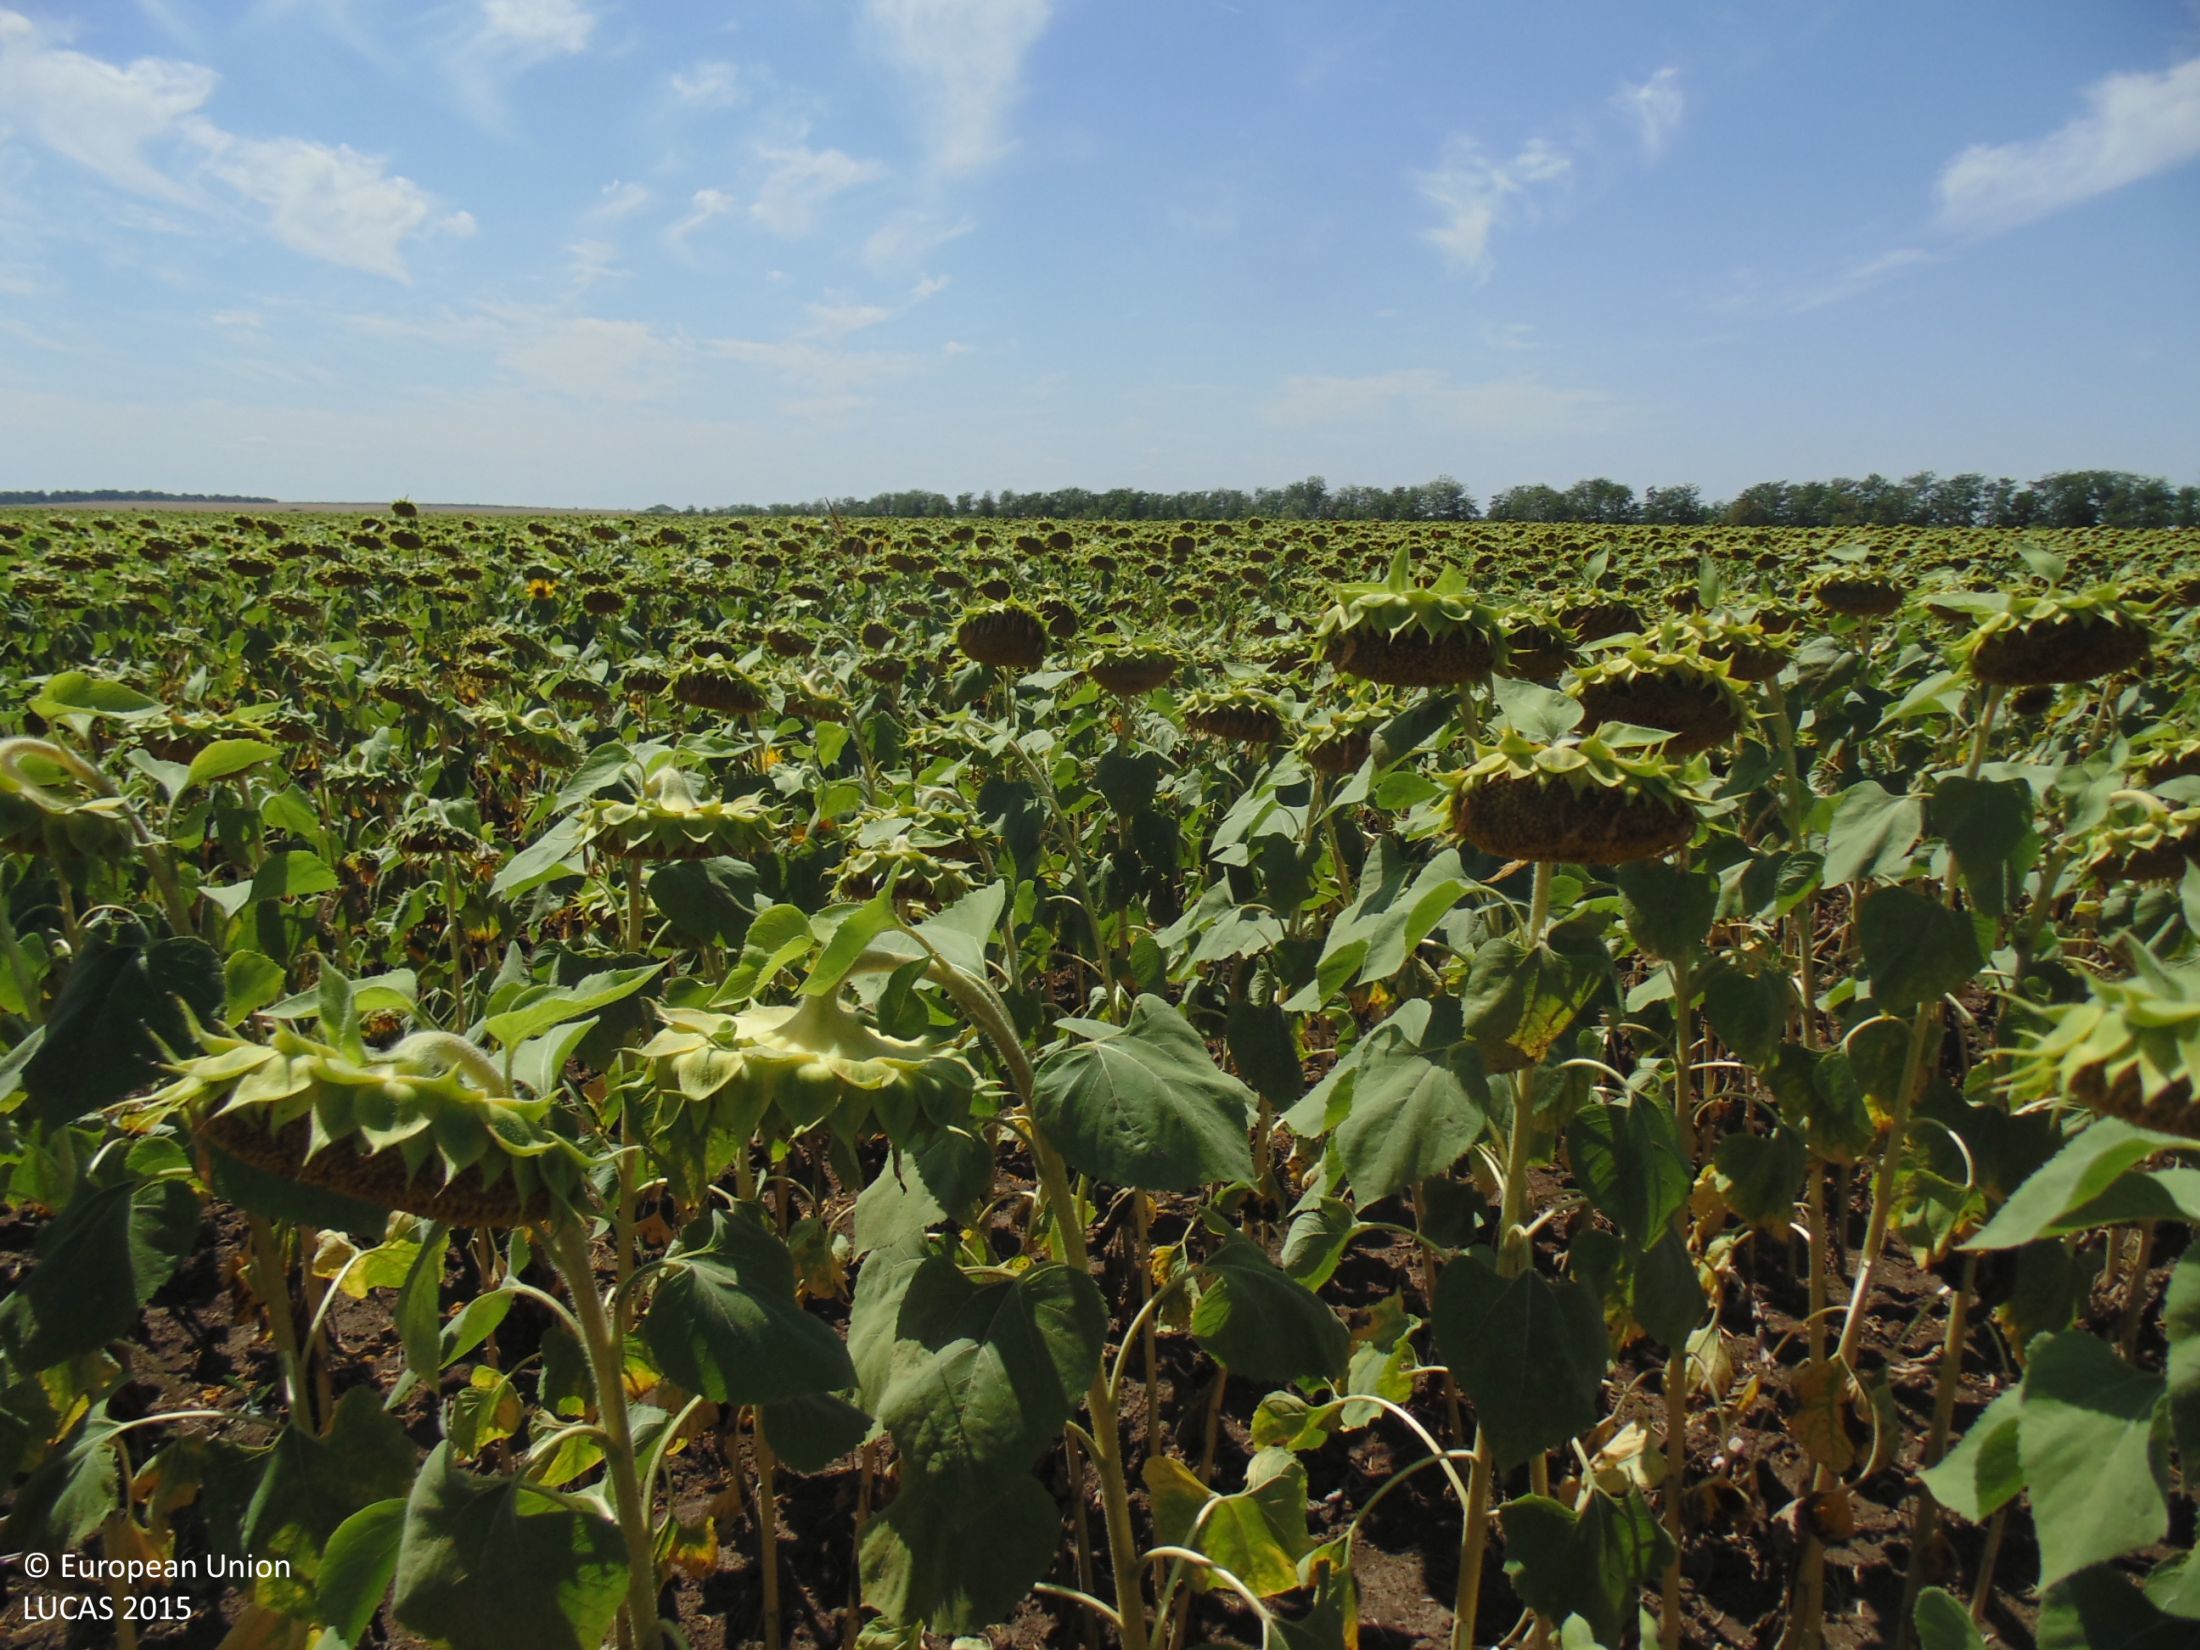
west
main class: Cropland
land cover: Sunflower
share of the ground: > 75 %
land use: Agriculture (excluding fallow land and kitchen gardens)
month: August
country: BG
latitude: 43.7999
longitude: 27.7542
